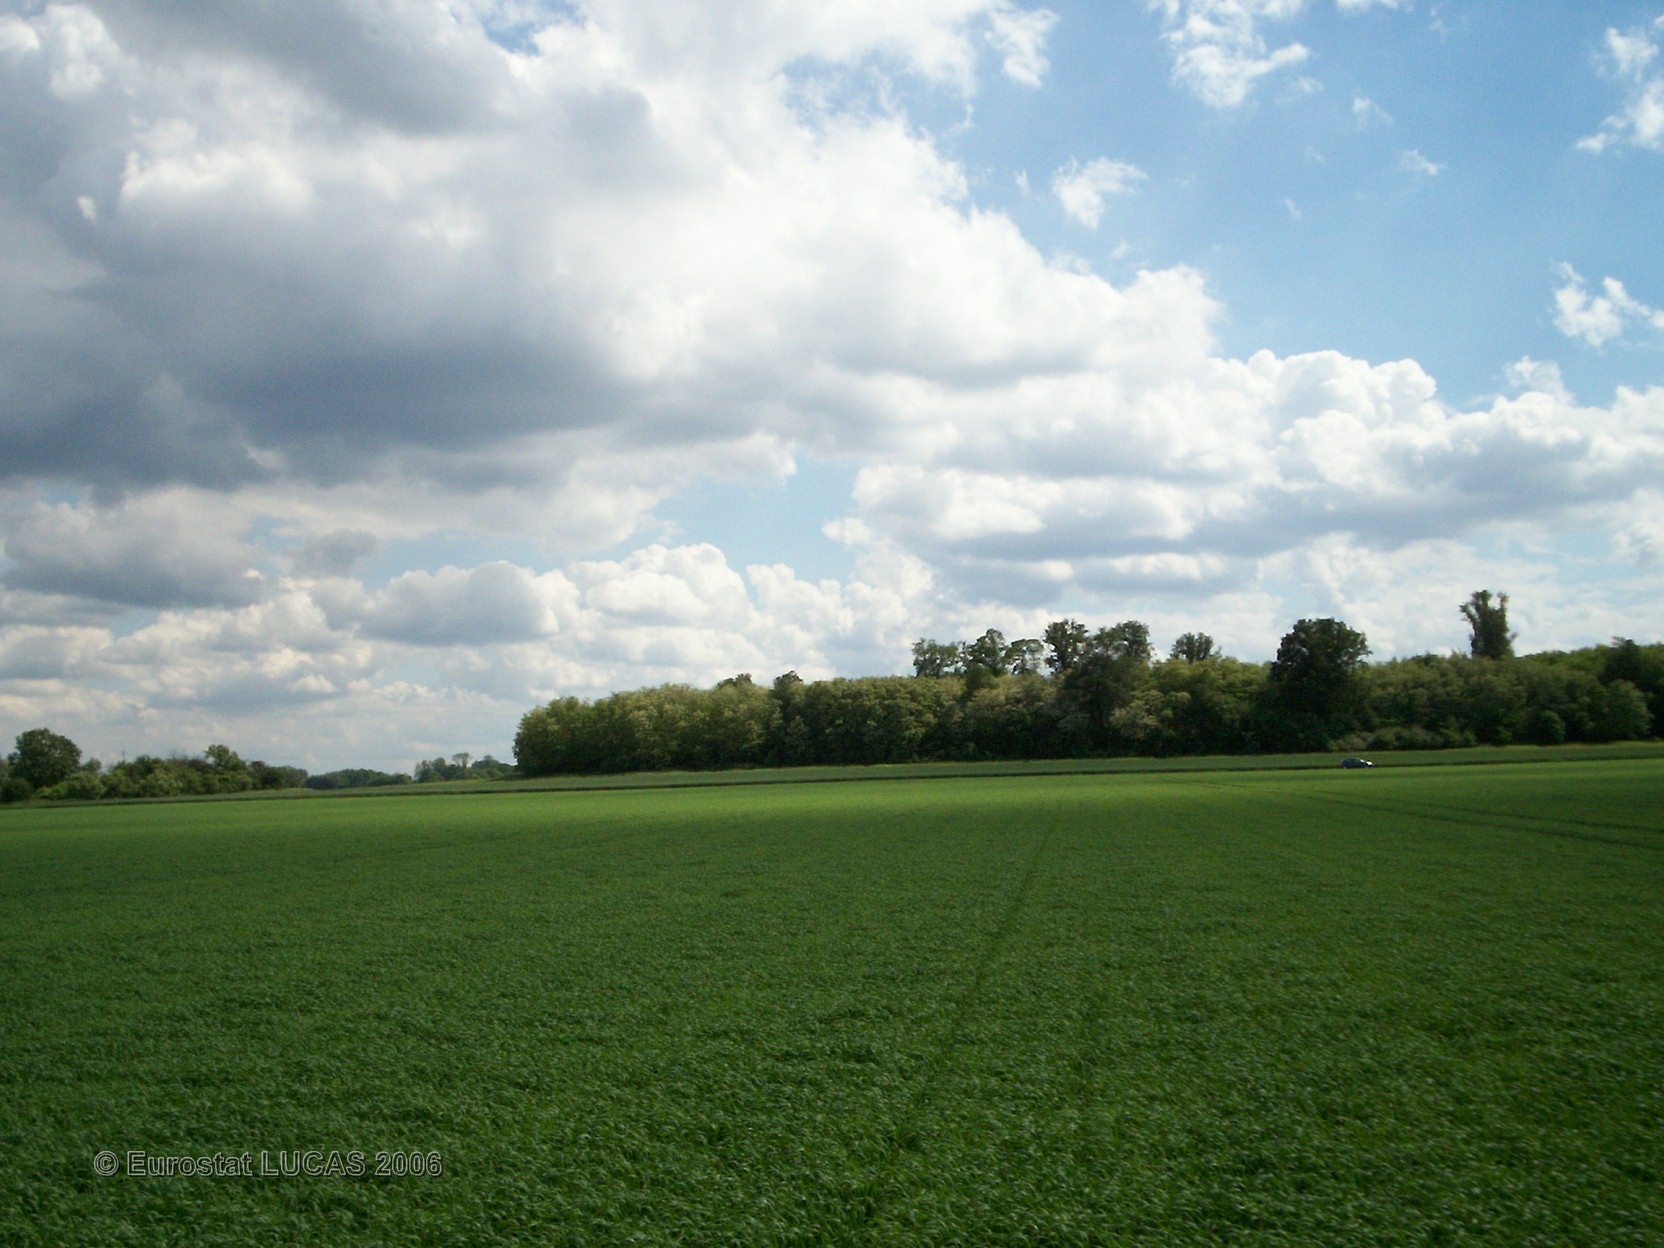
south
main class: Cropland
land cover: Barley
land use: Agriculture (excluding fallow land and kitchen gardens)
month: May
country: FR
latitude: 48.5443
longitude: 2.7437
